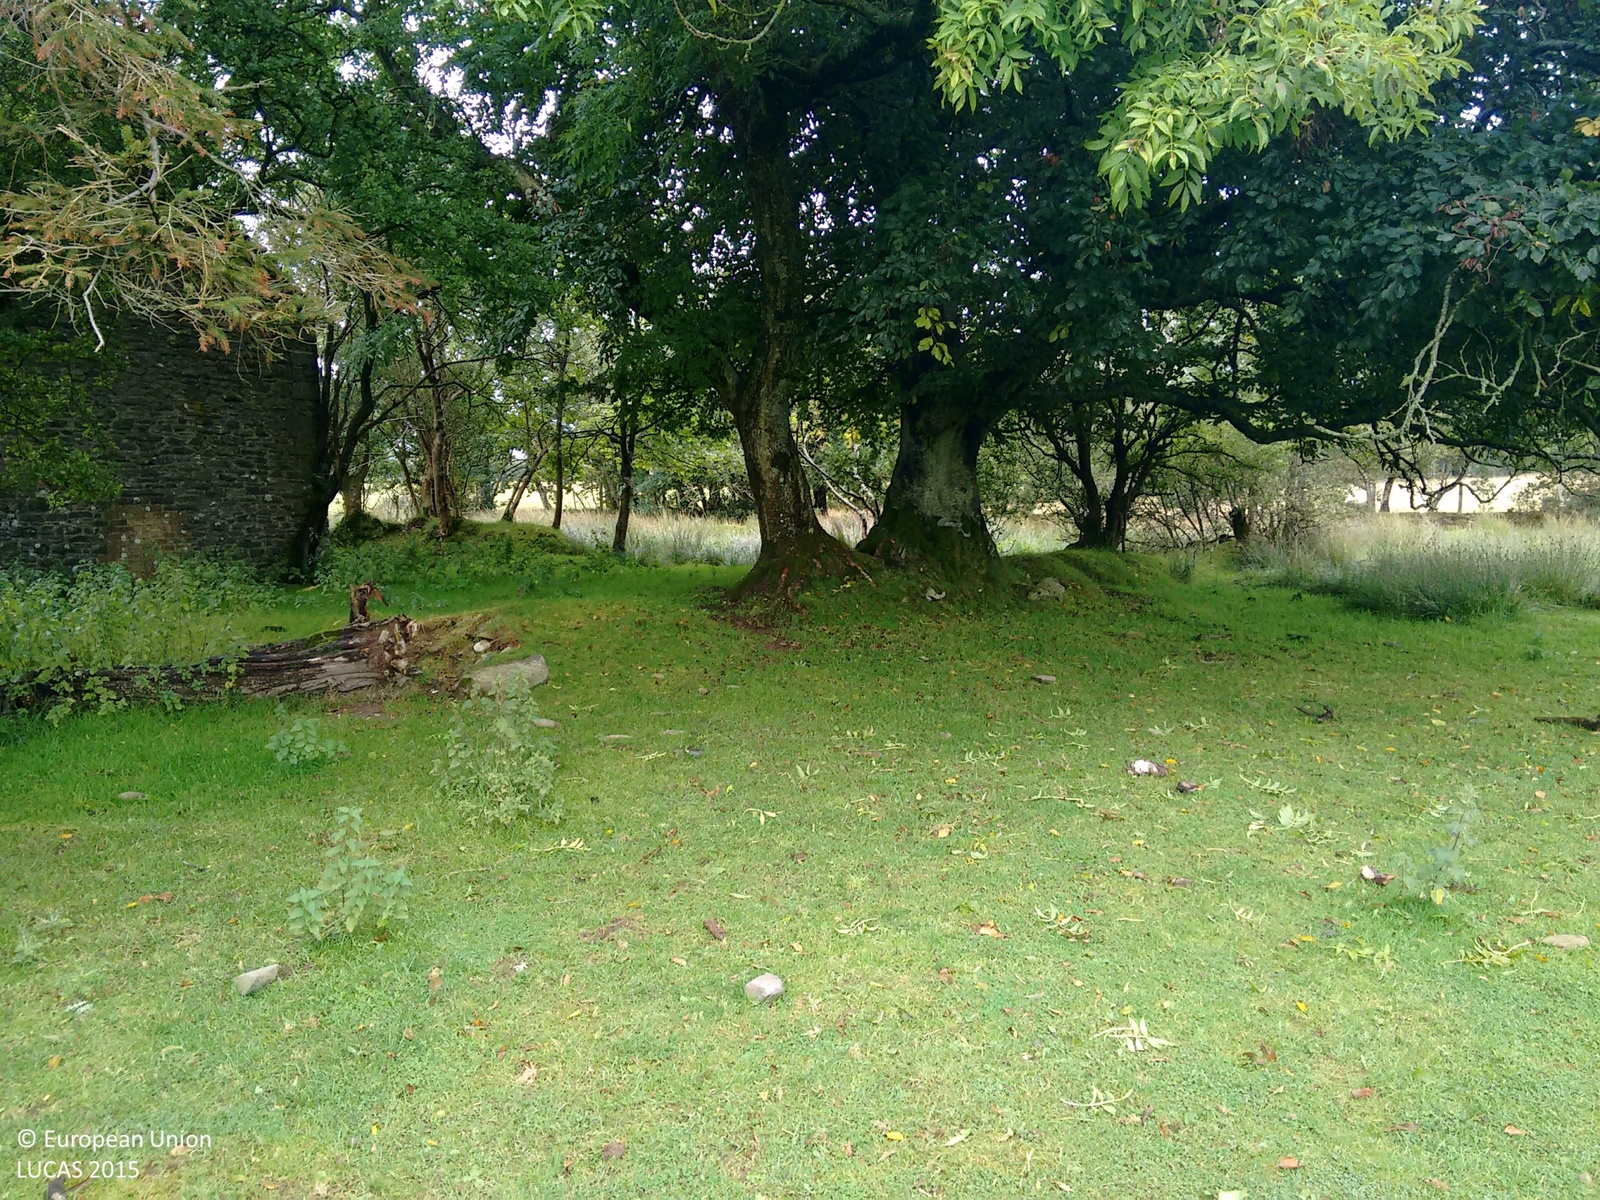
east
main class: Grassland
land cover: Grassland without tree/shrub cover
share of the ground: > 75 %
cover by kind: herbaceous plants 100 %
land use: Agriculture (excluding fallow land and kitchen gardens)
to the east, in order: Grassland without tree/shrub cover; Broadleaved woodland; Grassland without tree/shrub cover; Ditches and canals; Fences; Lines of trees; Grassland without tree/shrub cover; Fences; Lines of trees; Grassland without tree/shrub cover
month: September
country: GB
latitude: 52.2021
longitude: -3.9799
